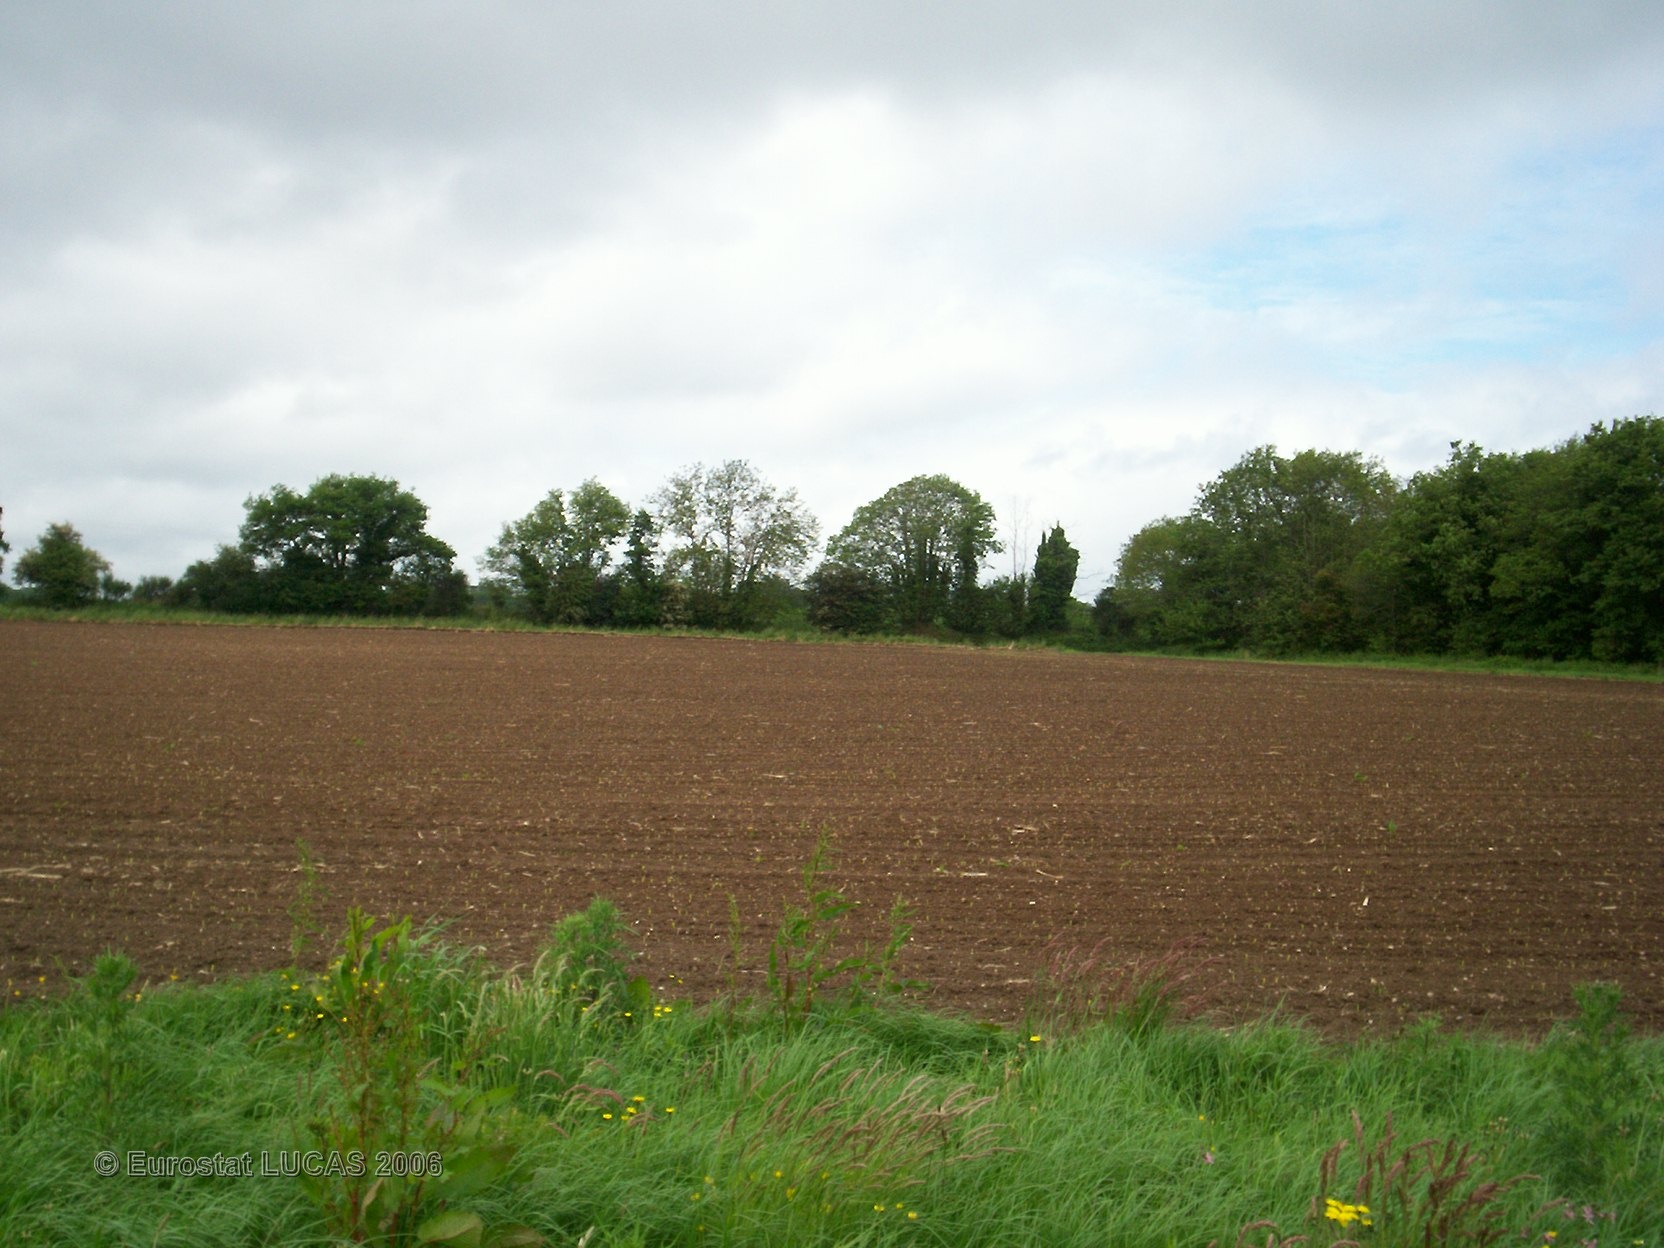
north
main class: Grassland
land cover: Grassland without tree/shrub cover
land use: Fallow land
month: May
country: FR
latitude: 47.9465
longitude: -3.5599
